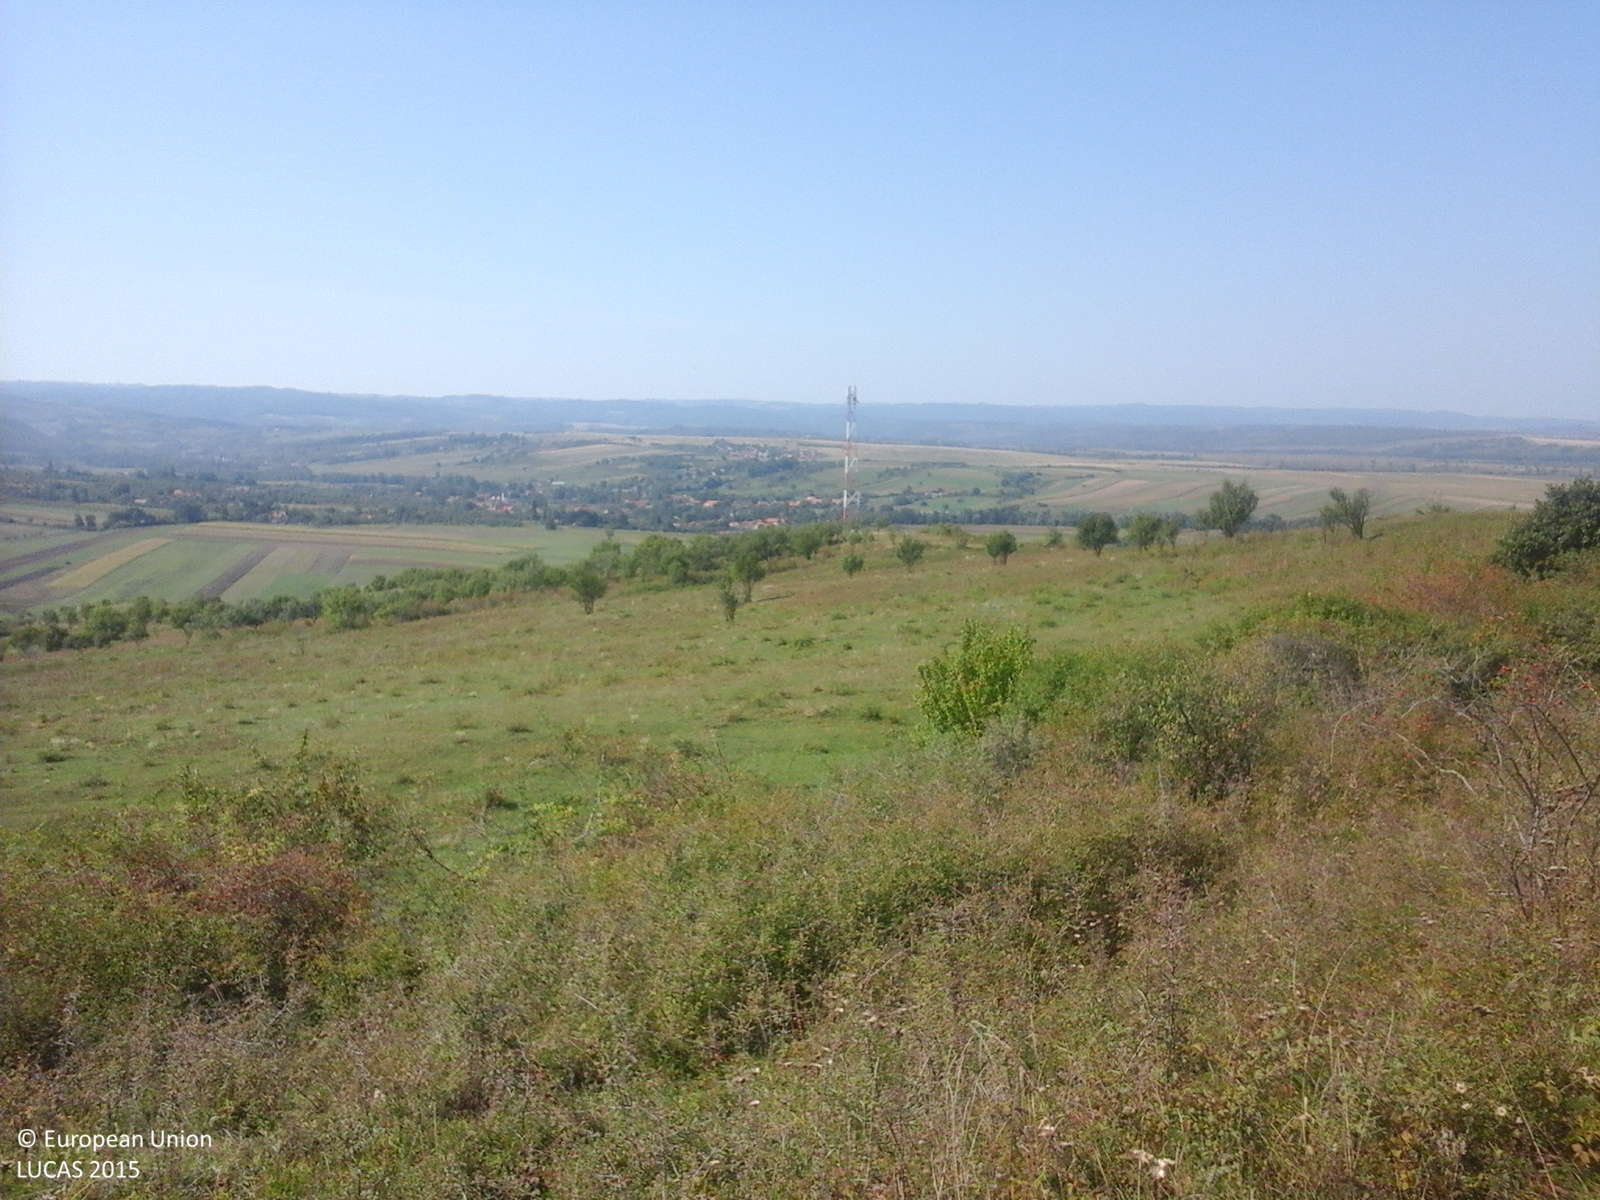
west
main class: Grassland
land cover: Grassland without tree/shrub cover
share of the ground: > 75 %
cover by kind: herbaceous plants 100 %
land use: Agriculture (excluding fallow land and kitchen gardens)
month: September
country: RO
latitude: 47.1152
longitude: 22.7506
